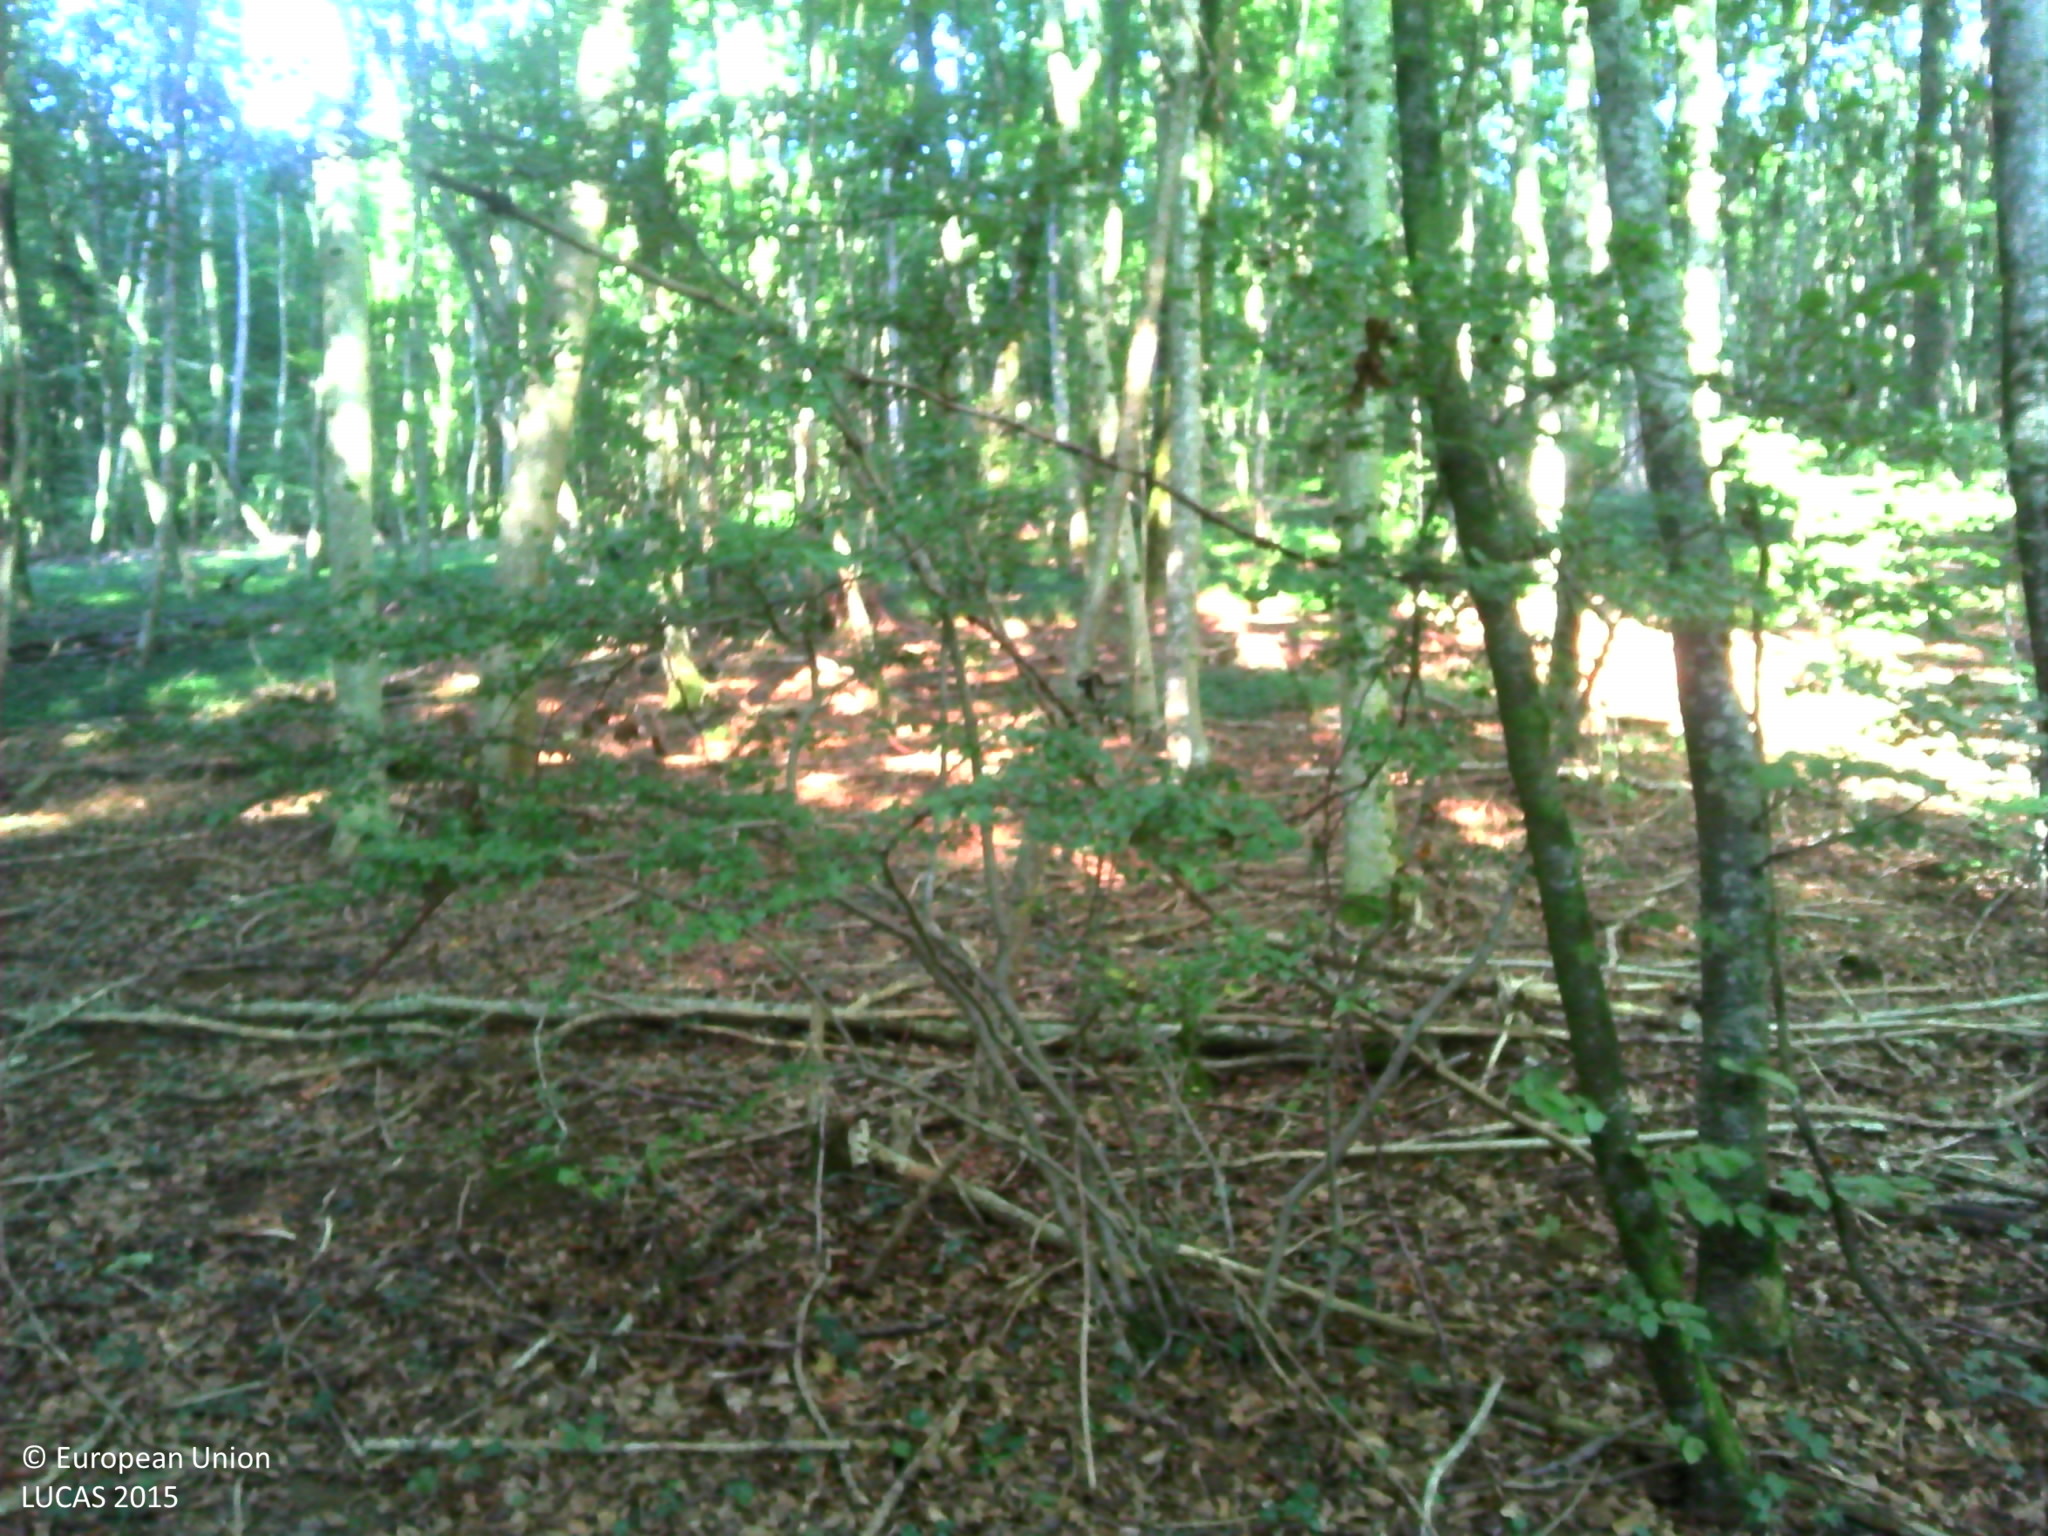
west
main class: Woodland
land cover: Broadleaved woodland
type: beech forest
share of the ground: > 75 %
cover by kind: broadleaved forest trees 100 %
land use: Forestry
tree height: > 5 m
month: September
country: FR
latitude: 47.3348
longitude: 6.3625
